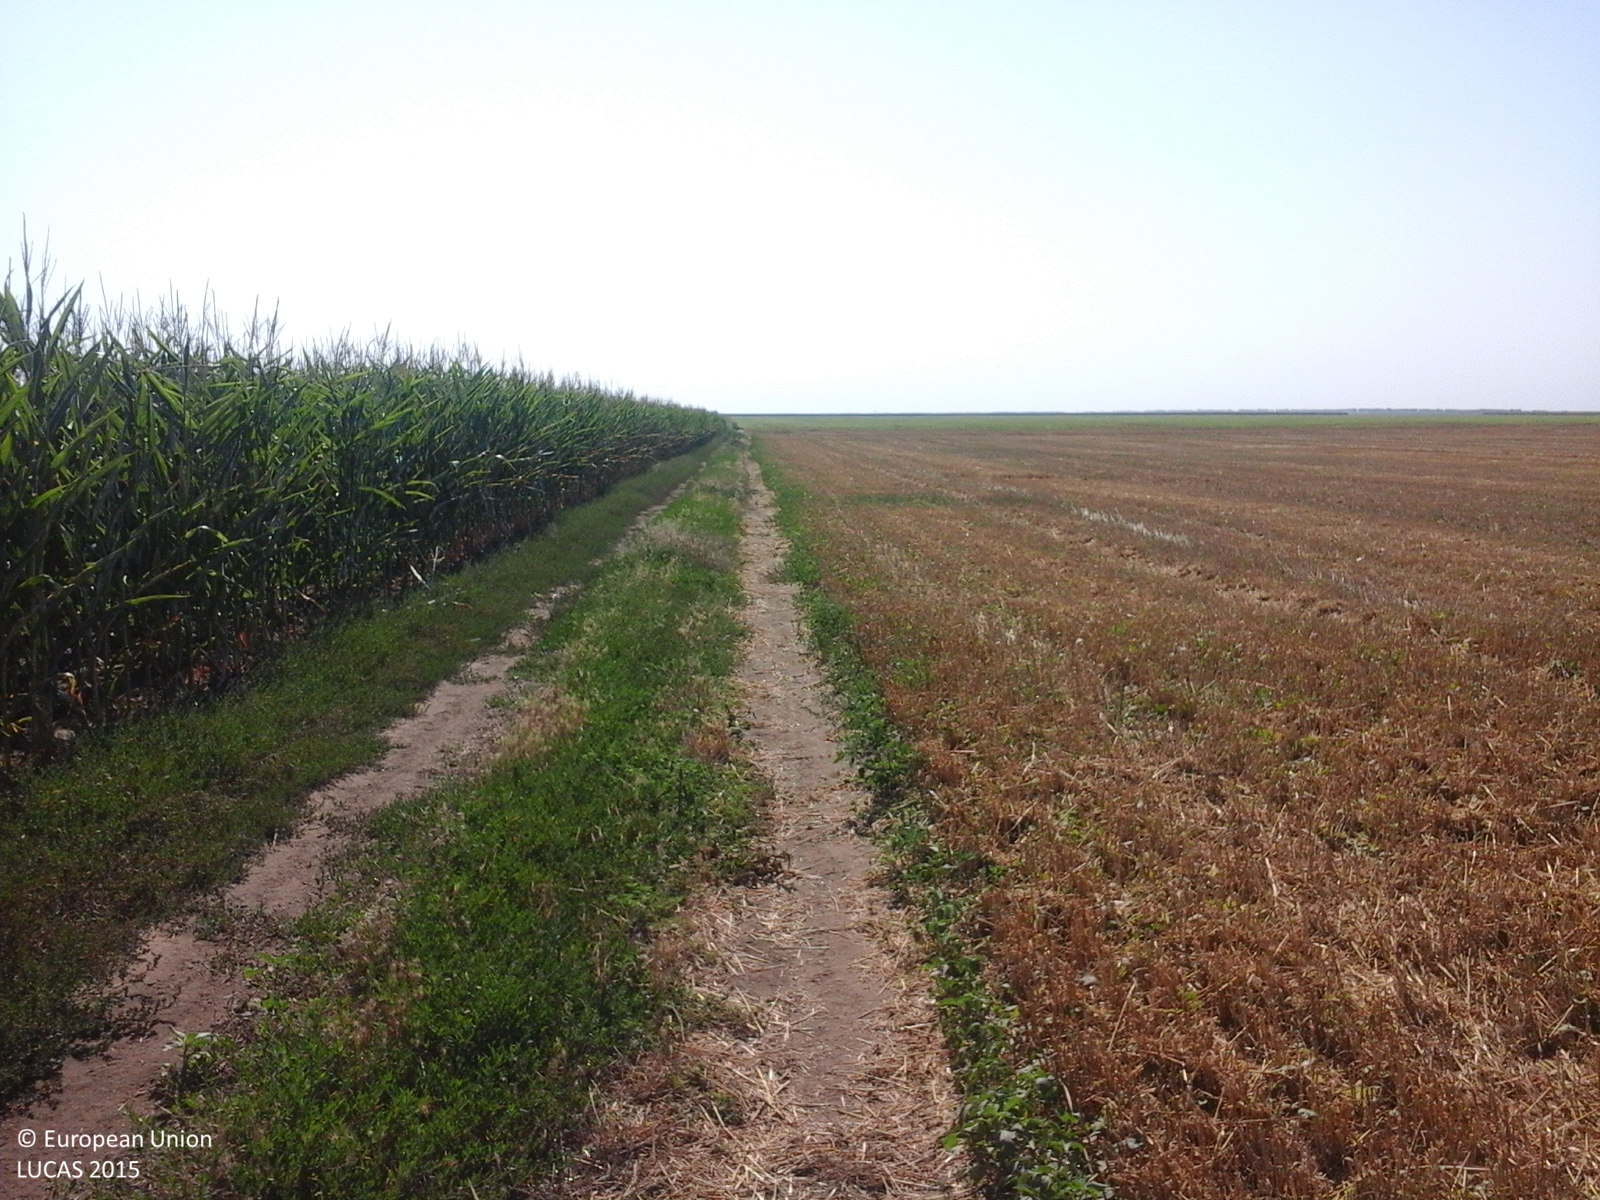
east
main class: Cropland
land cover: Maize
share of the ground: > 75 %
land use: Agriculture (excluding fallow land and kitchen gardens)
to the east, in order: Maize
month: July
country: RO
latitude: 44.7585
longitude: 27.1004
